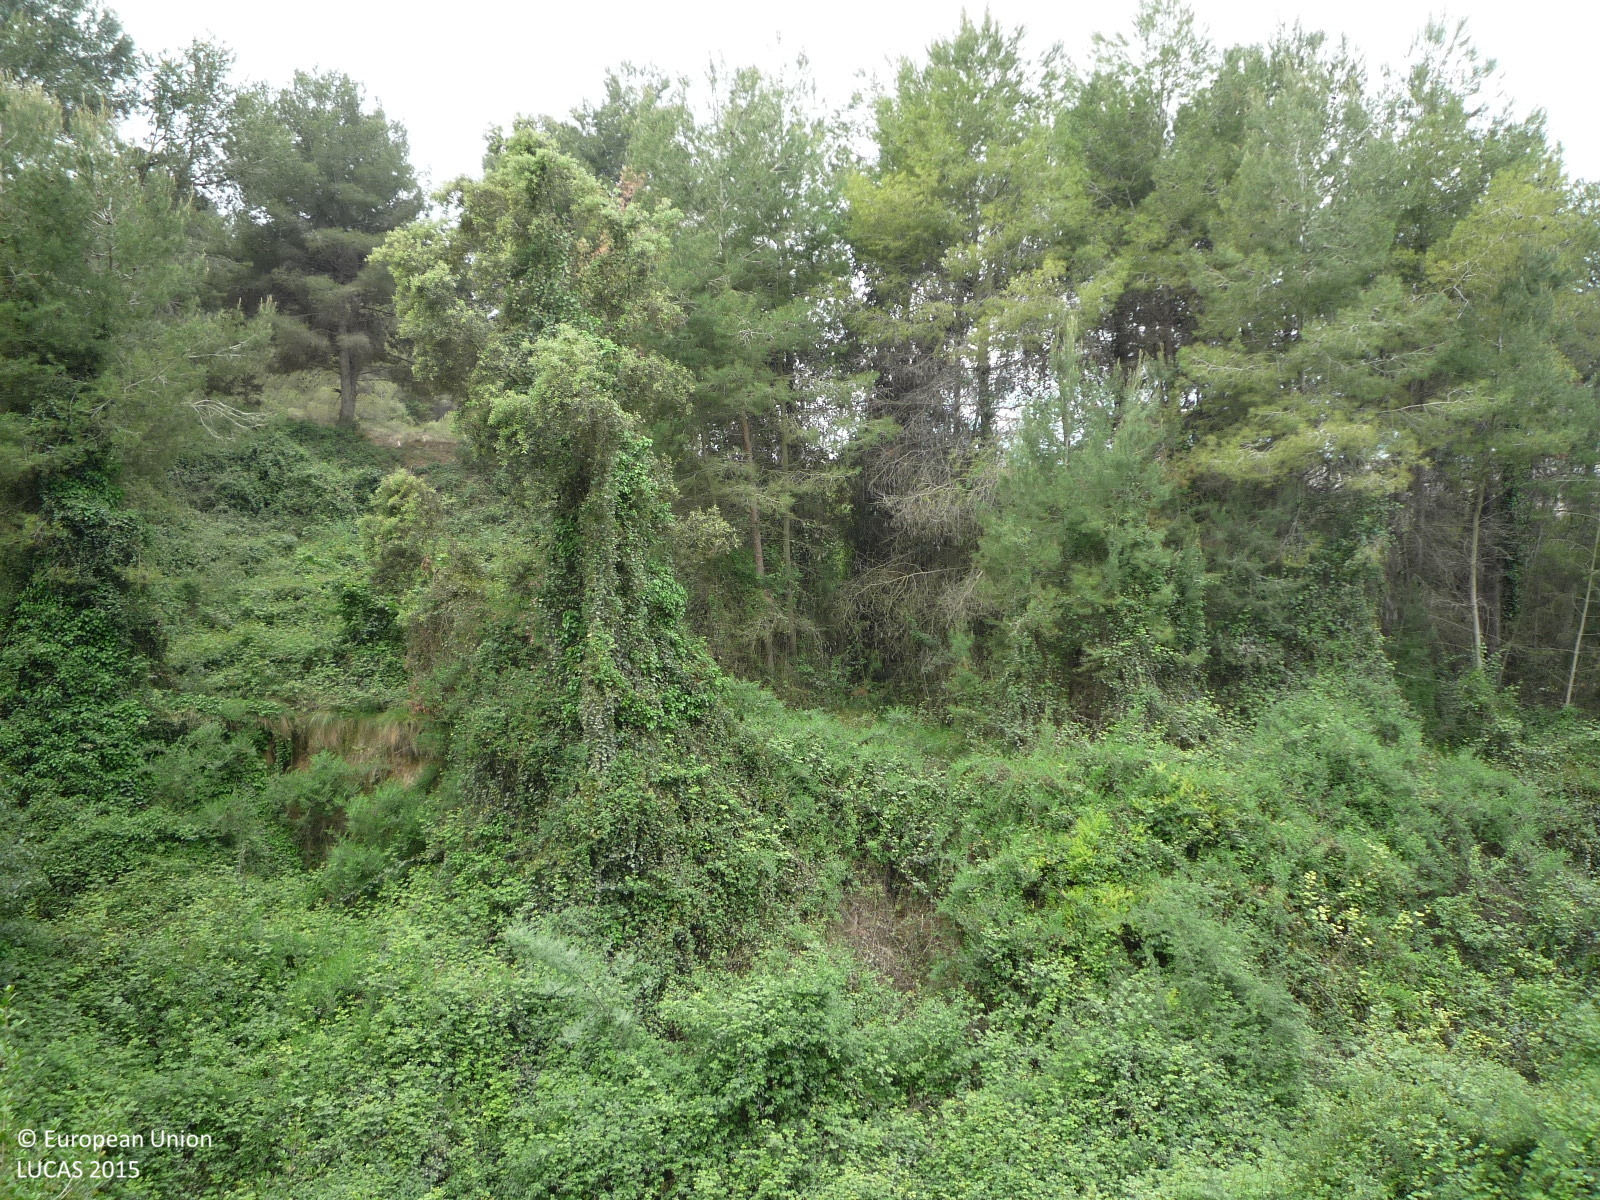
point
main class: Woodland
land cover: Pine dominated mixed woodland
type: coniferous forest of the mediterranean region
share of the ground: > 75 %
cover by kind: coniferous forest trees 60 %, broadleaved forest trees 35 %, shrubs 5 %
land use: Semi-natural and natural areas not in use
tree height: > 5 m
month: May
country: ES
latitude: 41.3117
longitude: 1.6680
